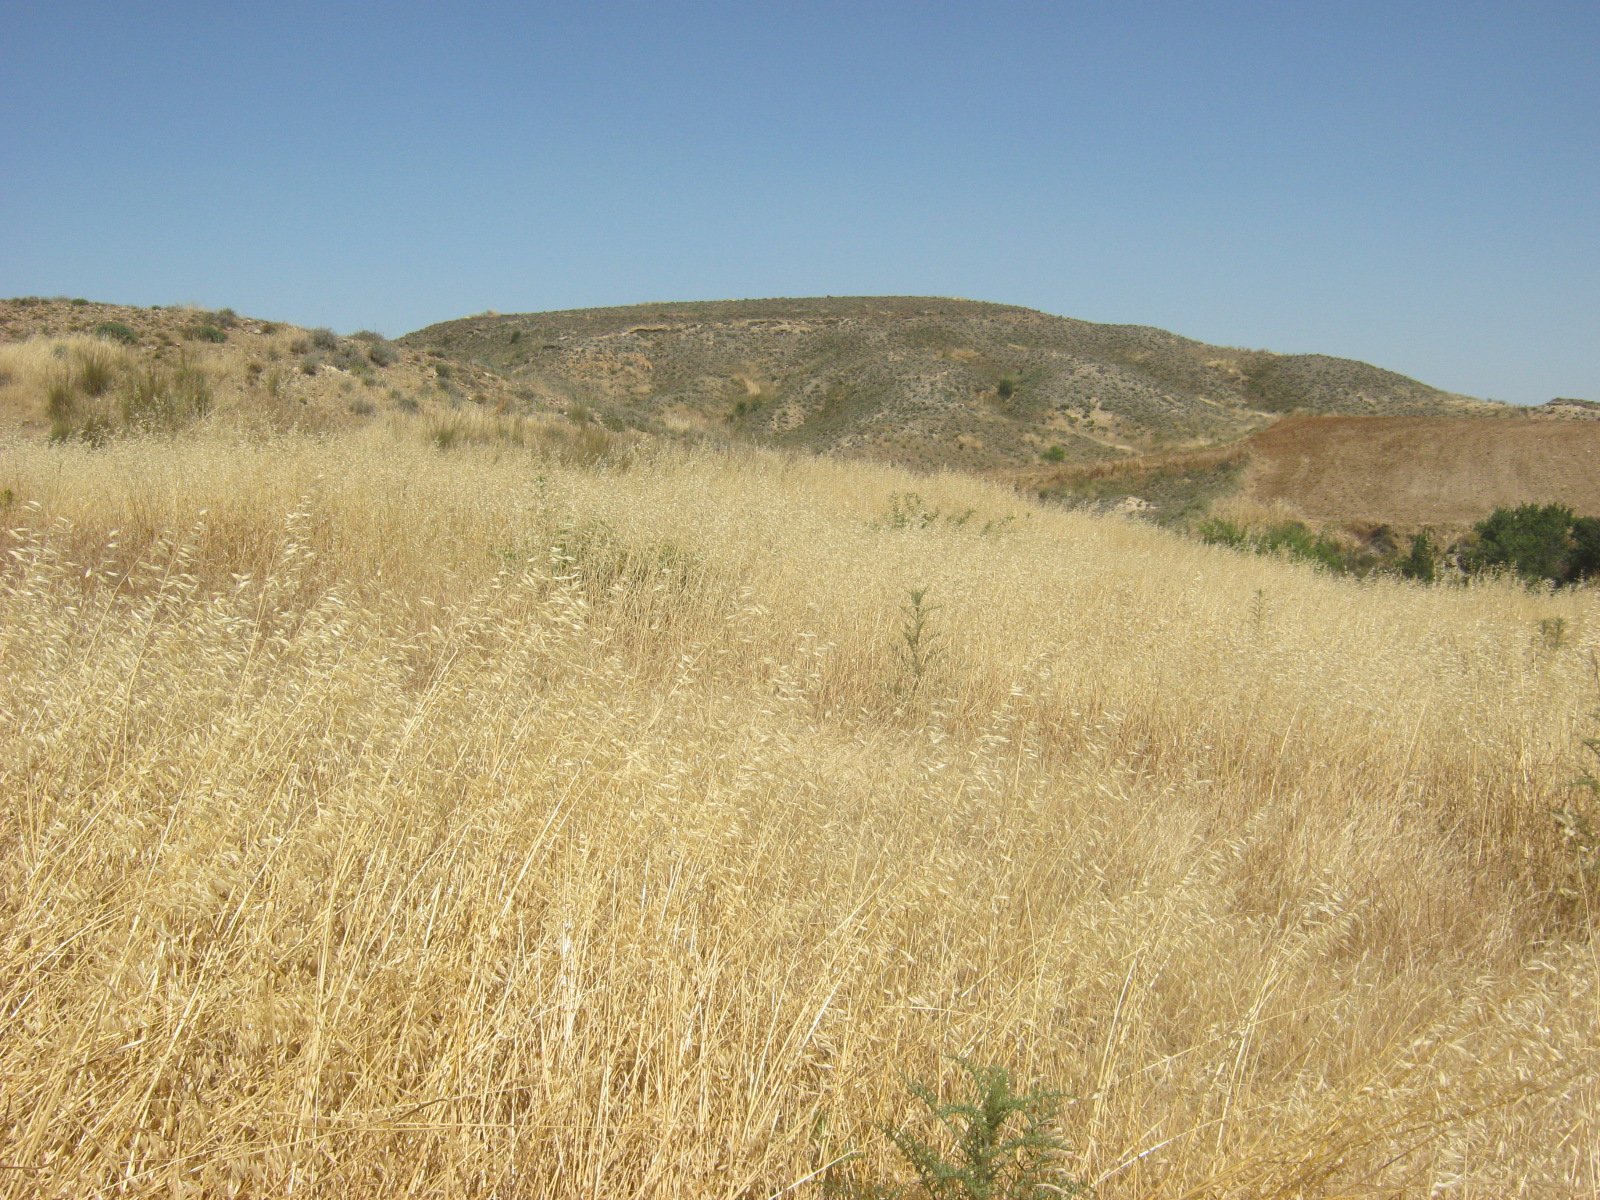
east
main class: Grassland
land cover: Spontaneously vegetated surfaces
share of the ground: > 75 %
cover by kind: herbaceous plants 100 %
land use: Semi-natural and natural areas not in use
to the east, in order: Spontaneously vegetated surfaces; Tracks; Spontaneously vegetated surfaces; Shrubland without tree cover; Rivers and streams; Shrubland without tree cover
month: May
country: CY
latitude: 35.0963
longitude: 33.2107
